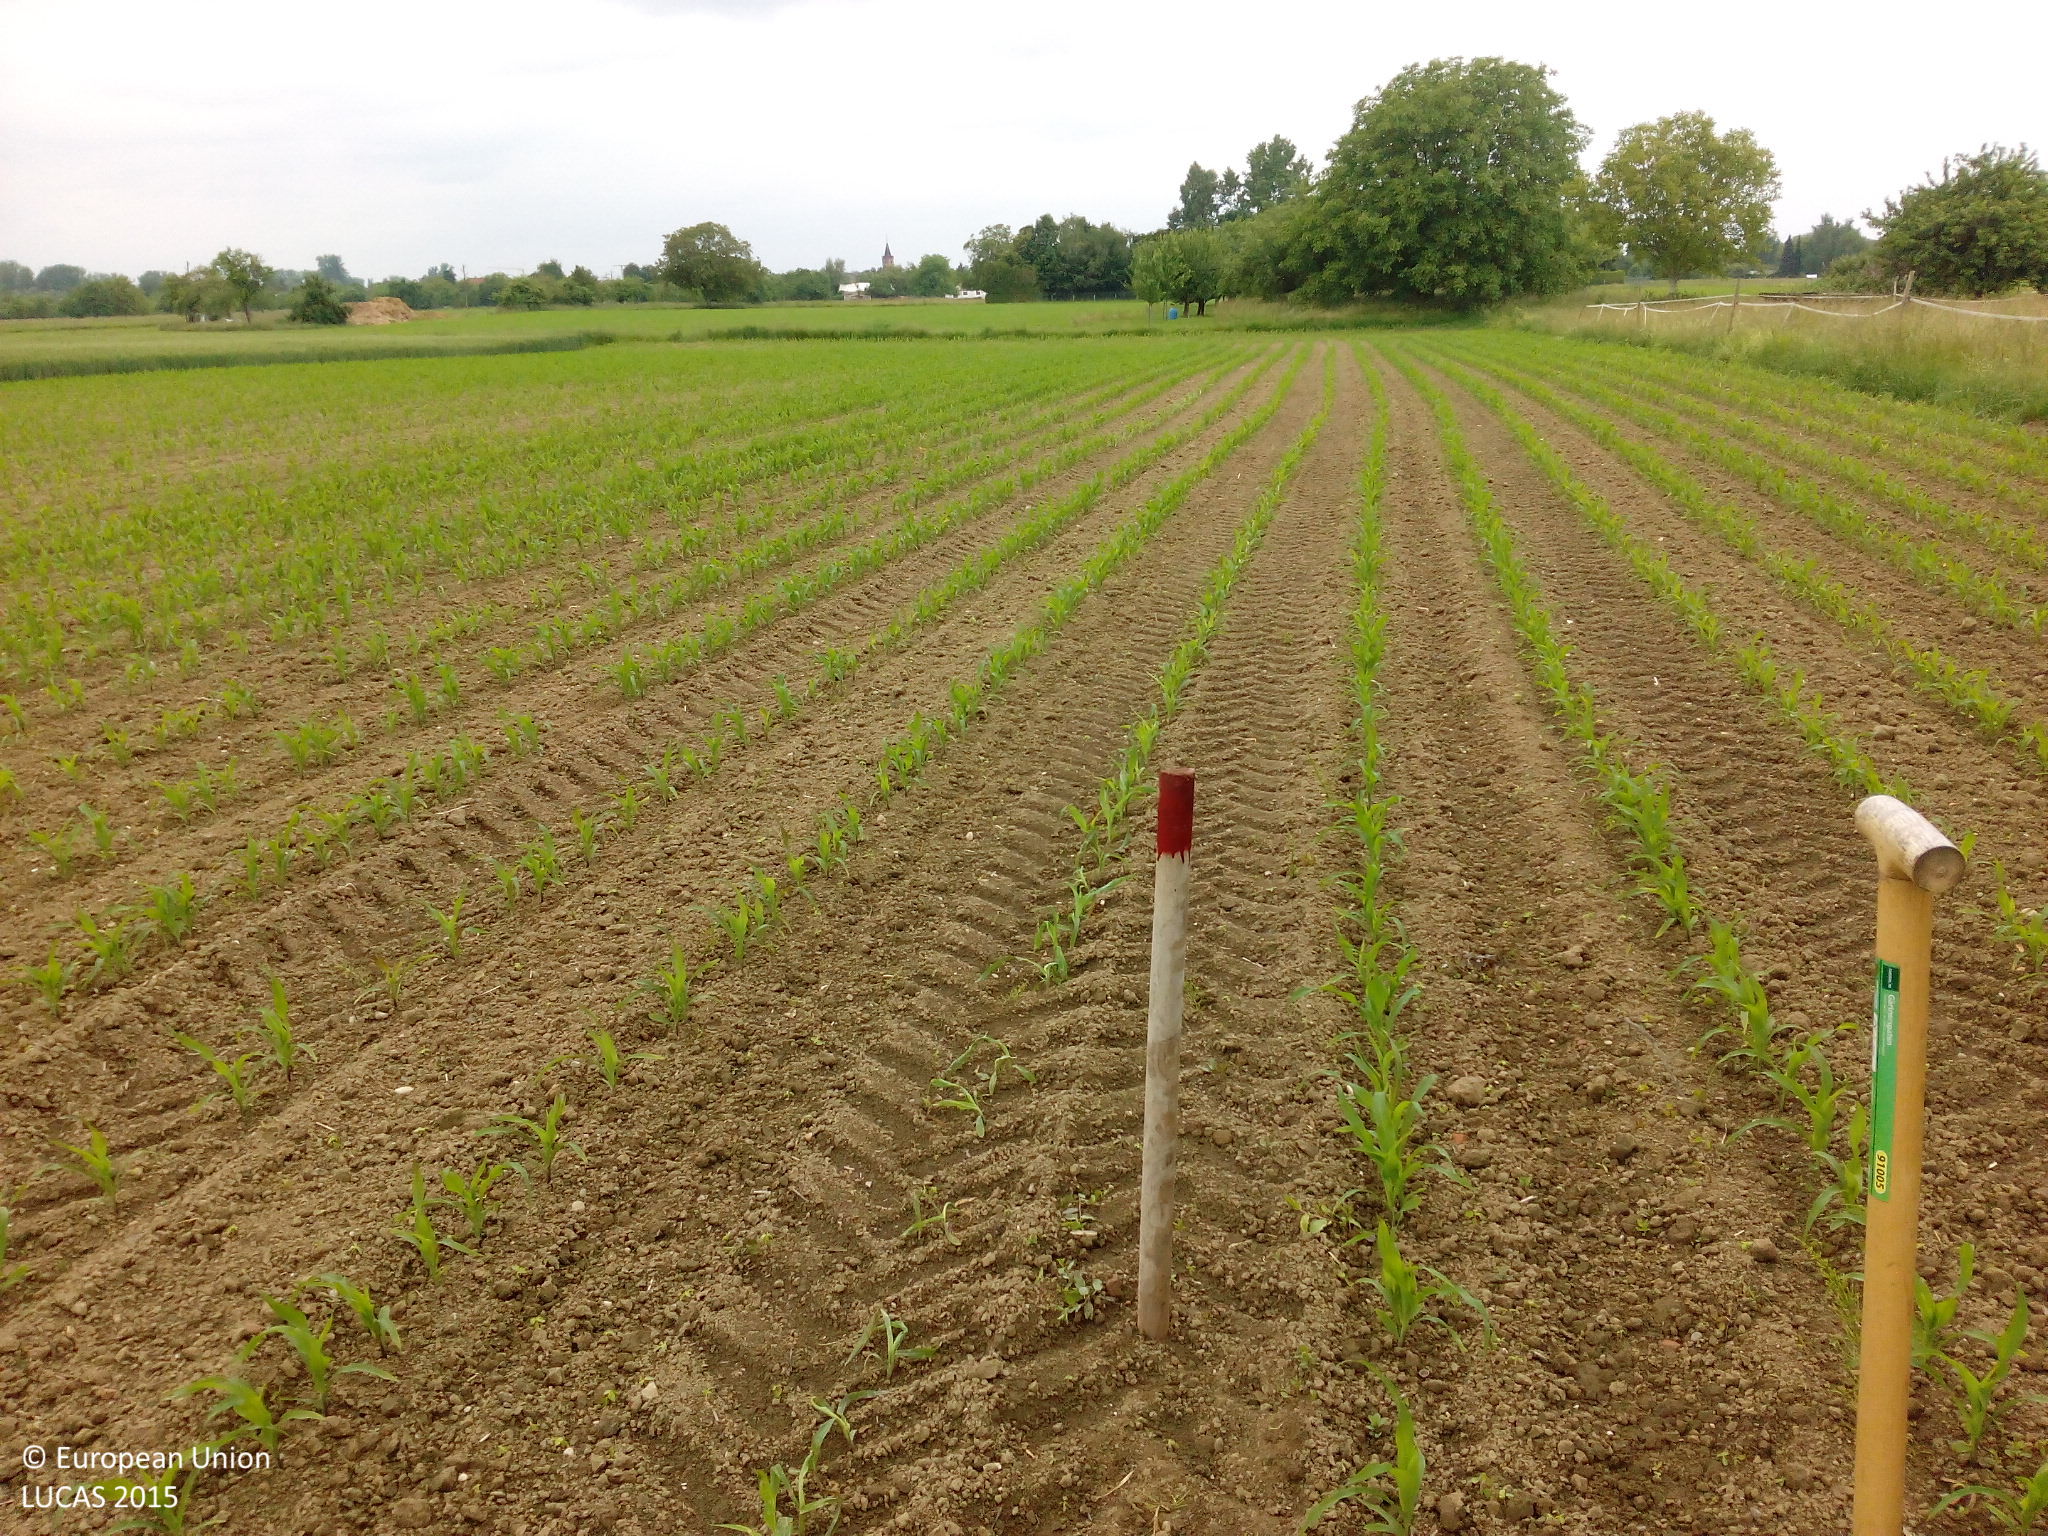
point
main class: Cropland
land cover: Maize
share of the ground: < 10 %
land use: Agriculture (excluding fallow land and kitchen gardens)
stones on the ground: < 10 %
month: May
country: DE
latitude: 48.8741
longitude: 8.1600
